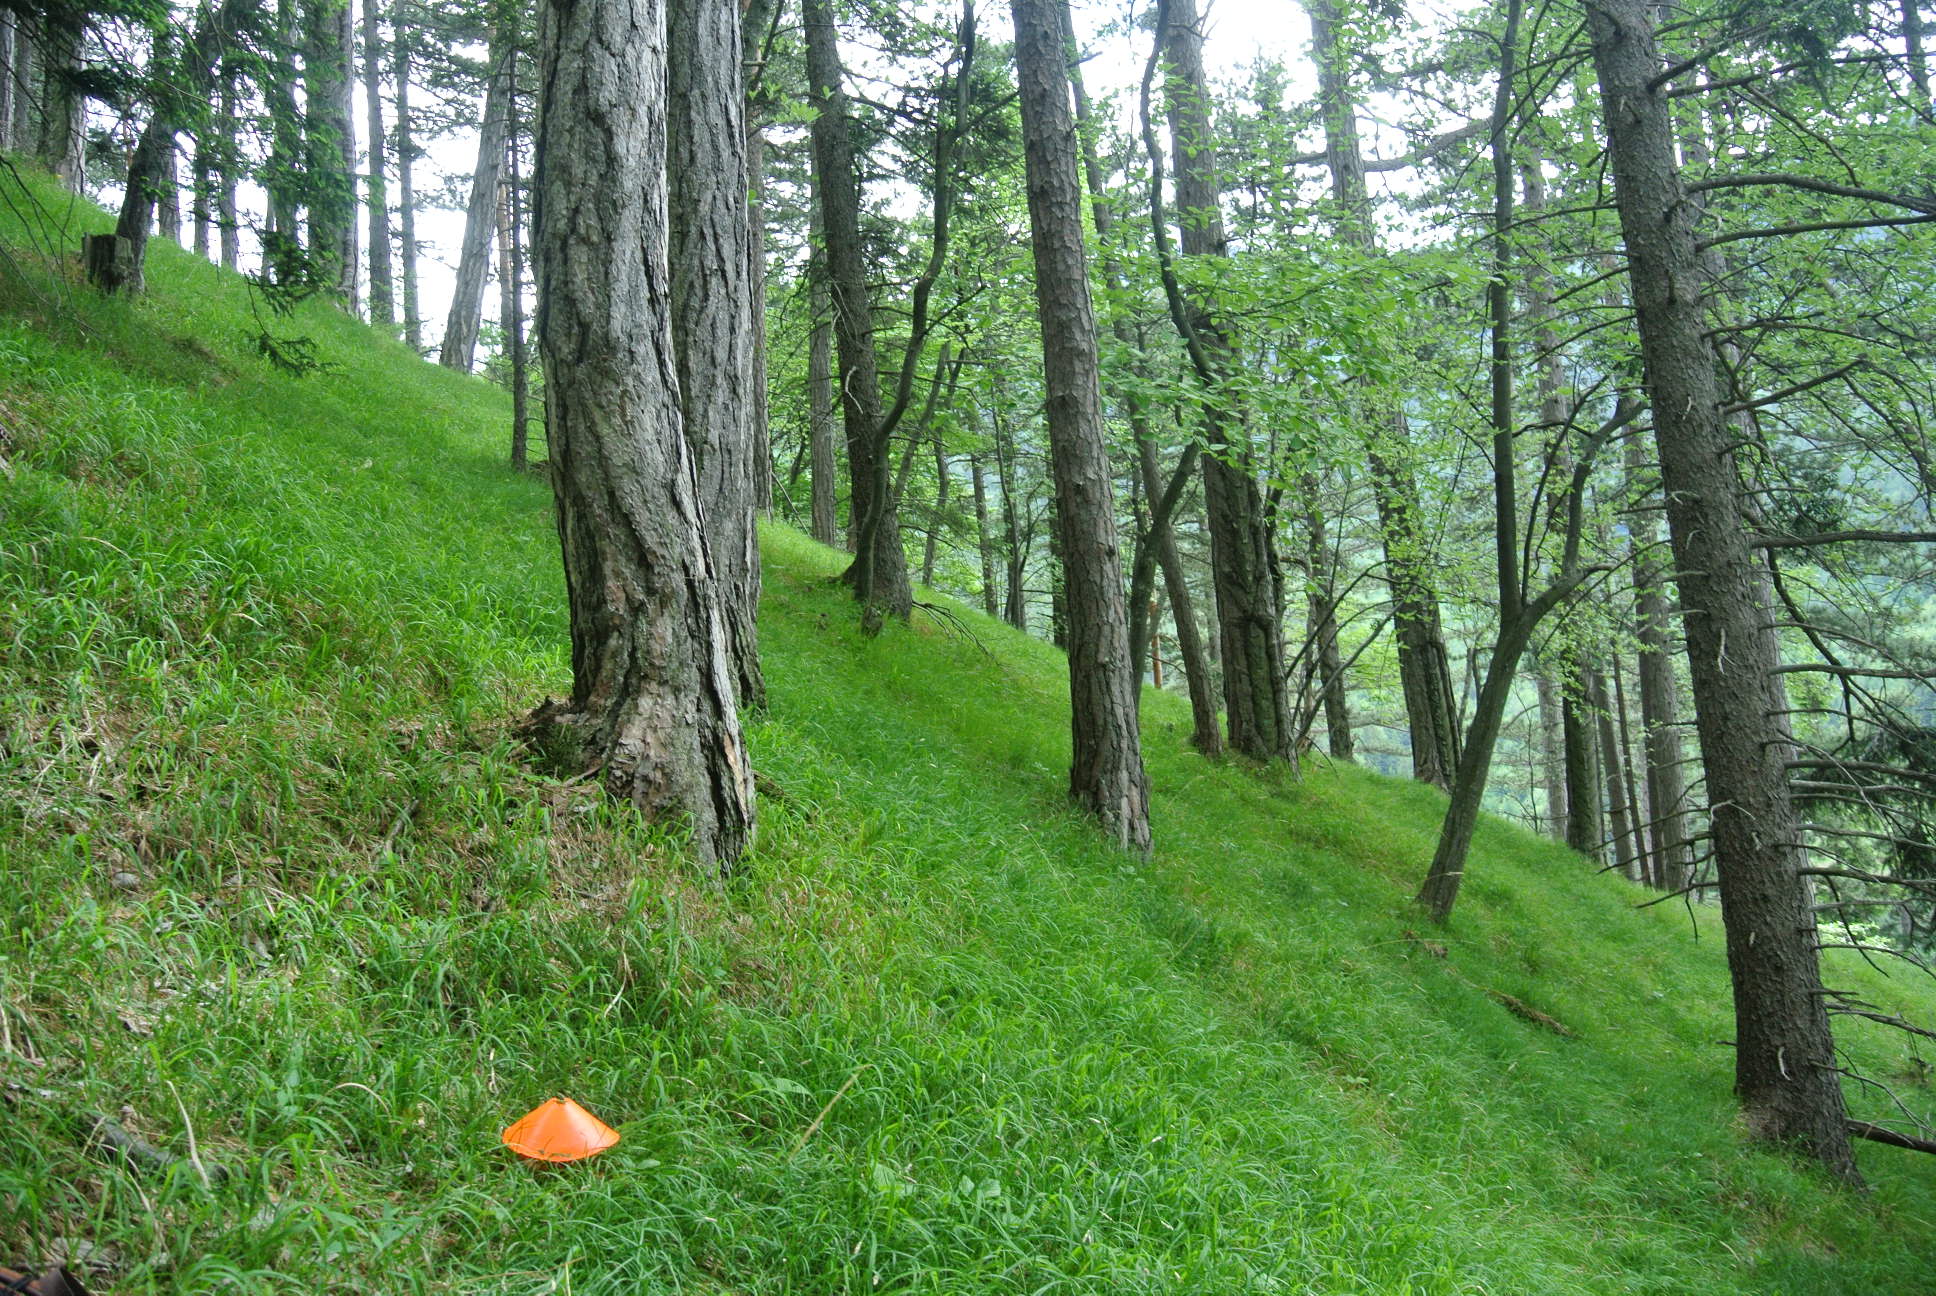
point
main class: Woodland
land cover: Other mixed woodland
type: alpine coniferous forest
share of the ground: > 75 %
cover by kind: coniferous forest trees 55 %, broadleaved forest trees 25 %, herbaceous plants 20 %
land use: Forestry
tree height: > 5 m
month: May
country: AT
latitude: 47.9611
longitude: 15.8285
